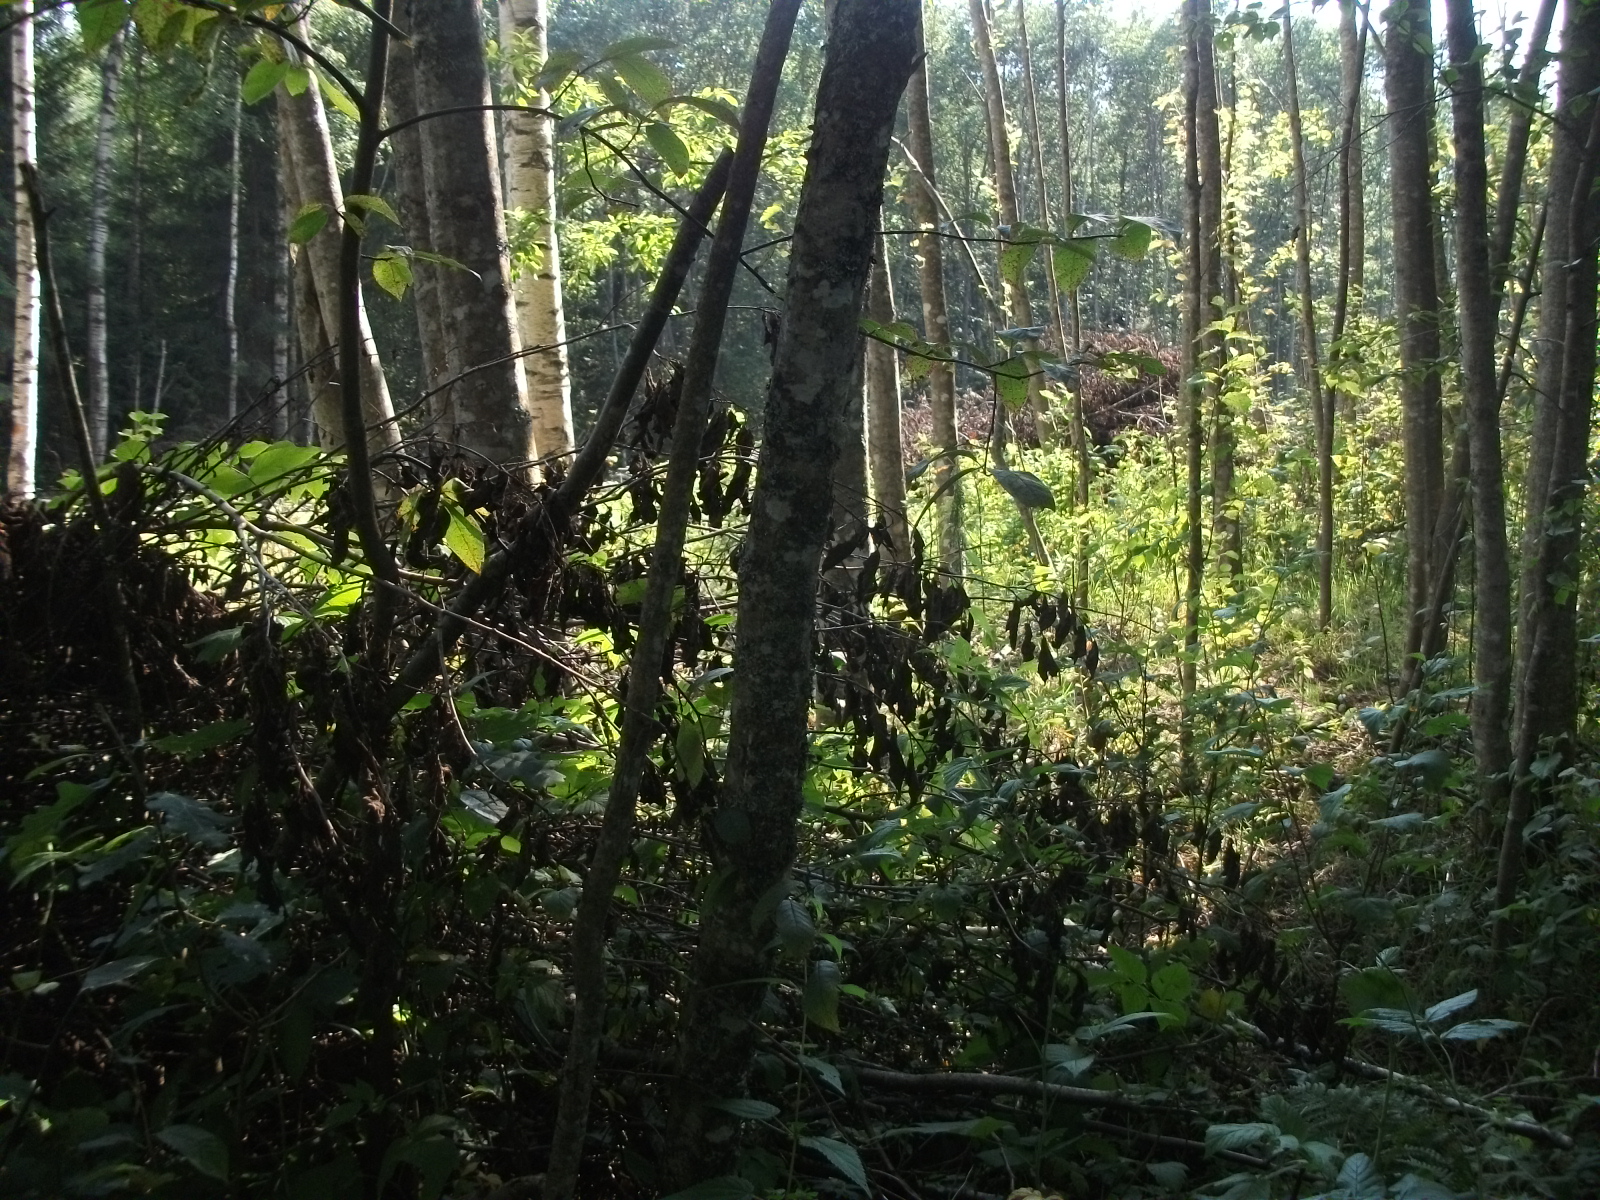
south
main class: Woodland
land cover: Broadleaved woodland
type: non-riverine alder, birch or aspen forest
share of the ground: > 75 %
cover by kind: broadleaved forest trees 85 %, herbaceous plants 10 %, shrubs 5 %
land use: Agriculture (excluding fallow land and kitchen gardens)
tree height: > 5 m
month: August
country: LV
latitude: 56.8061
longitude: 25.7326
